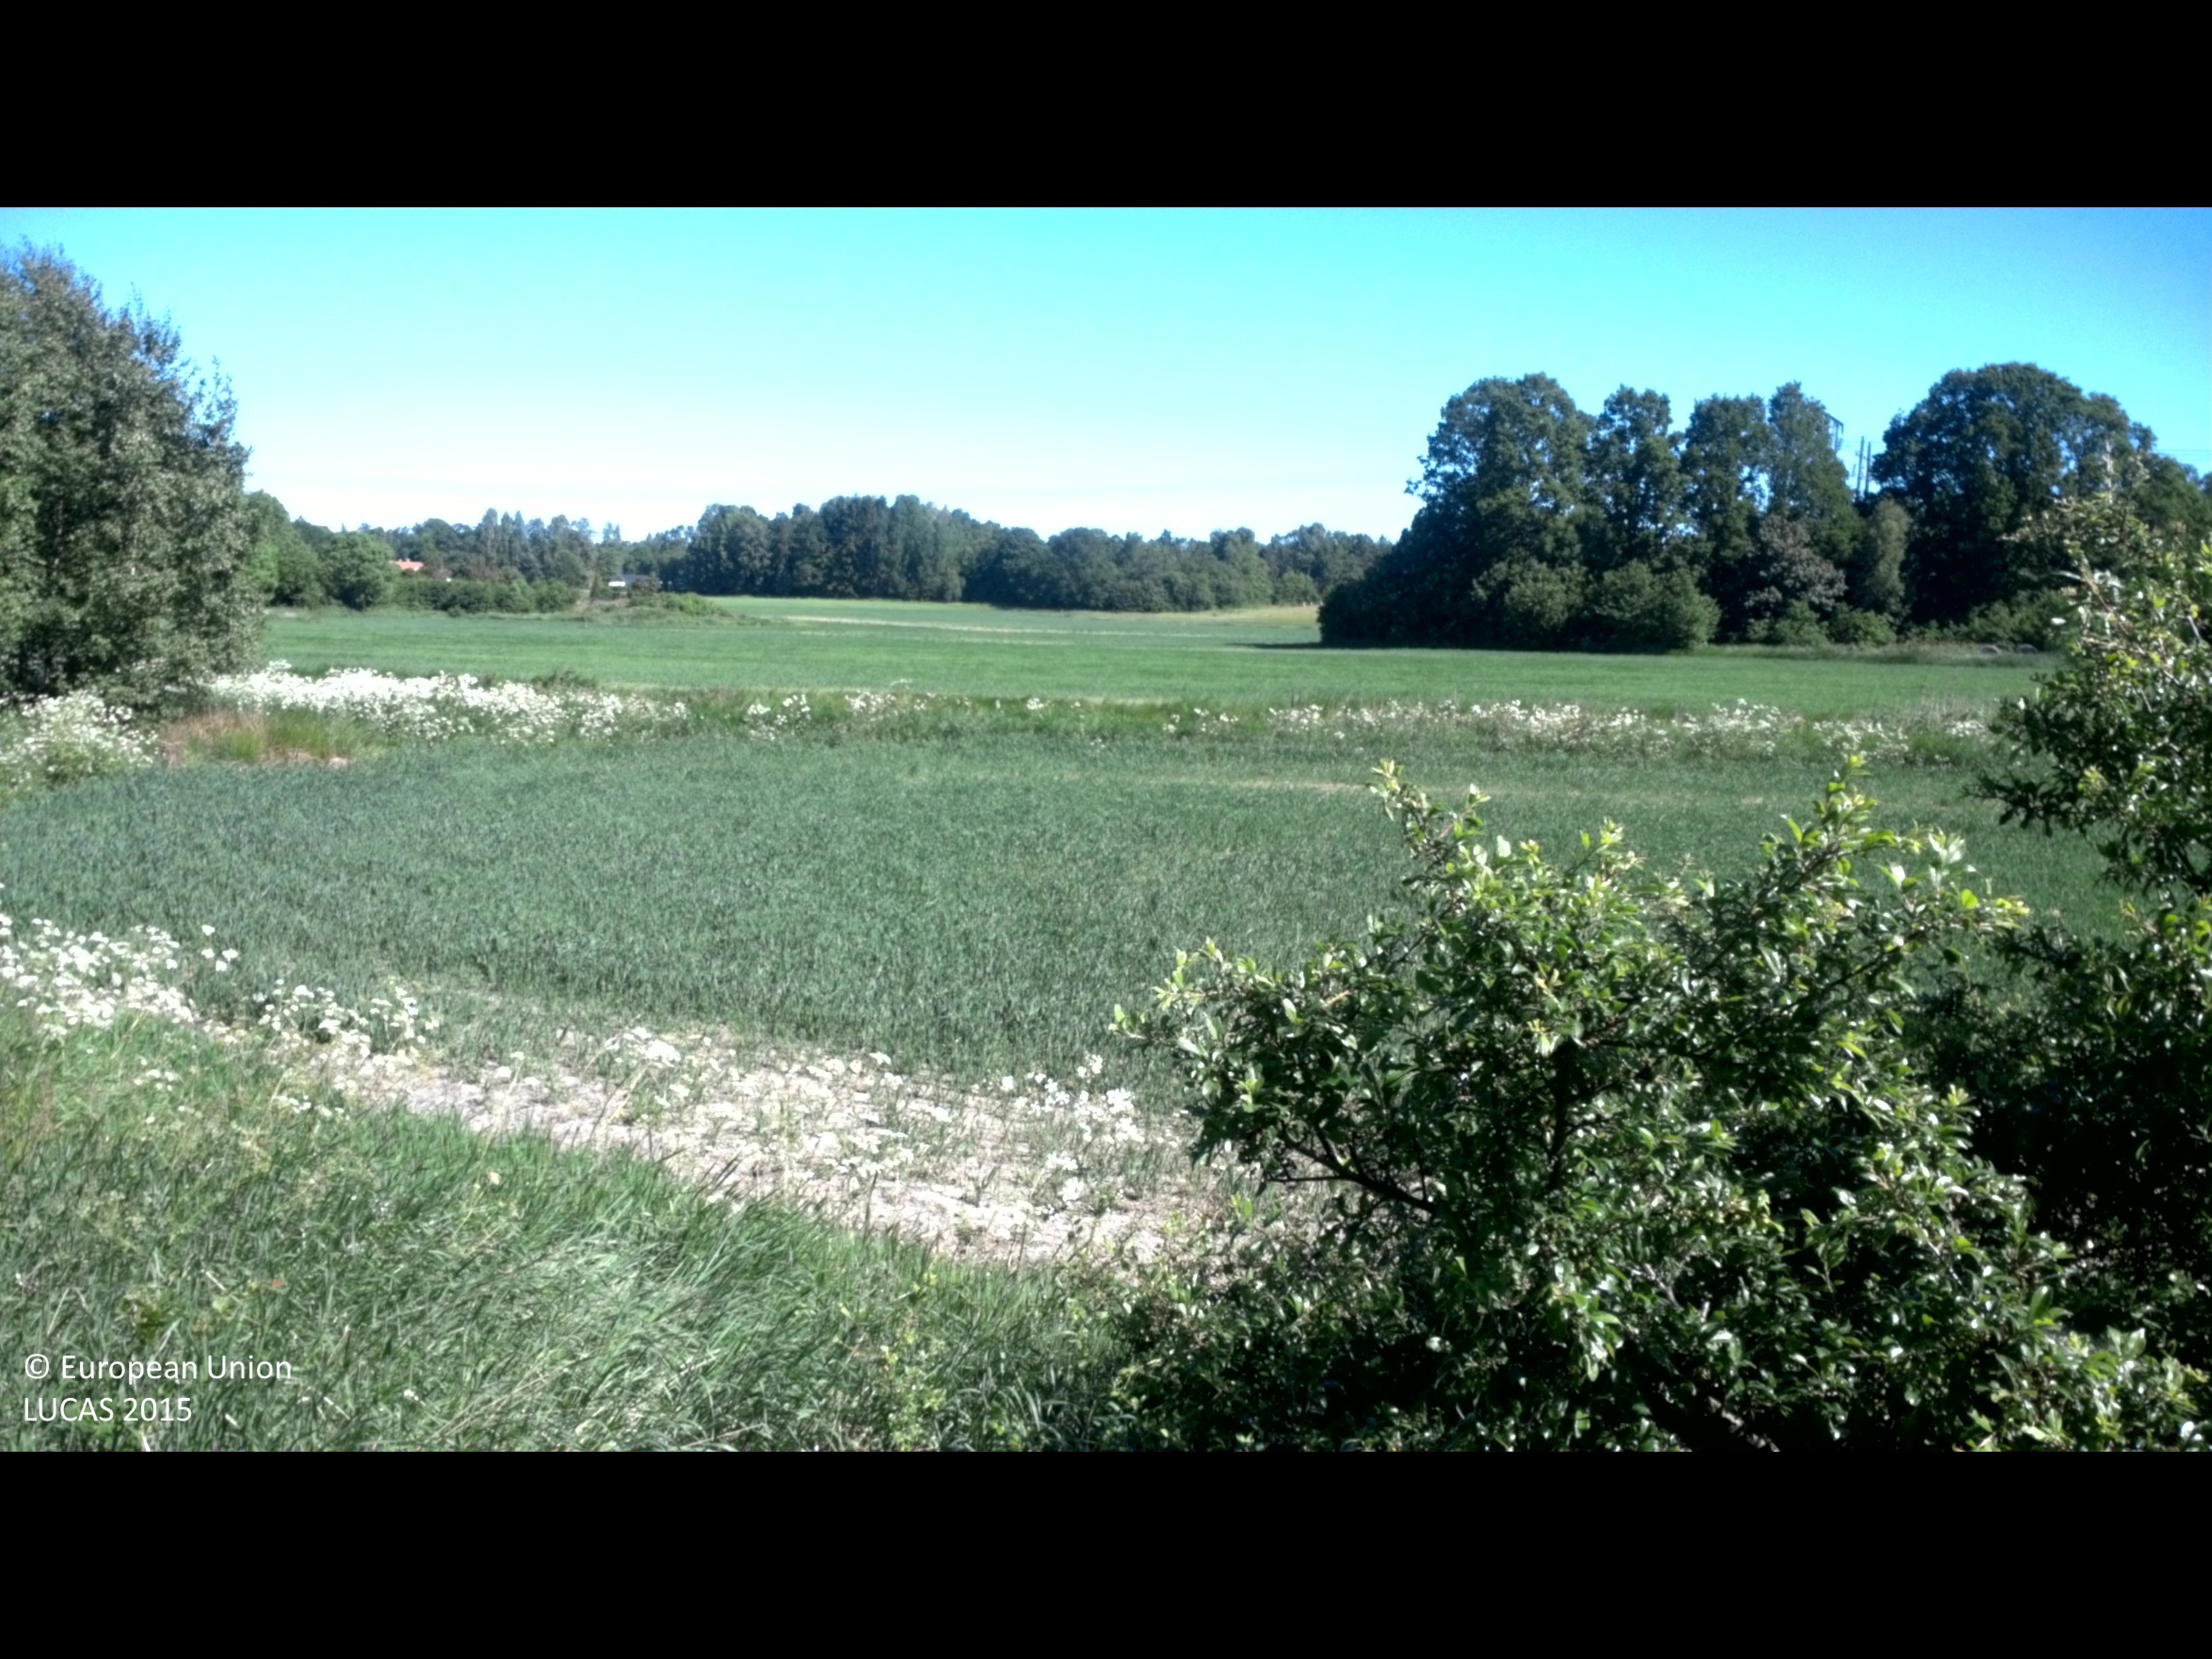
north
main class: Woodland
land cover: Broadleaved woodland
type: hemiboreal forest and nemoral coniferous forest and mixed broadleaved-coniferous forest
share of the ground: 50 - 75 %
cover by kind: broadleaved forest trees 75 %, herbaceous plants 20 %, shrubs 5 %
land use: Forestry
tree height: > 5 m
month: June
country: SE
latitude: 57.7308
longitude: 16.6323
